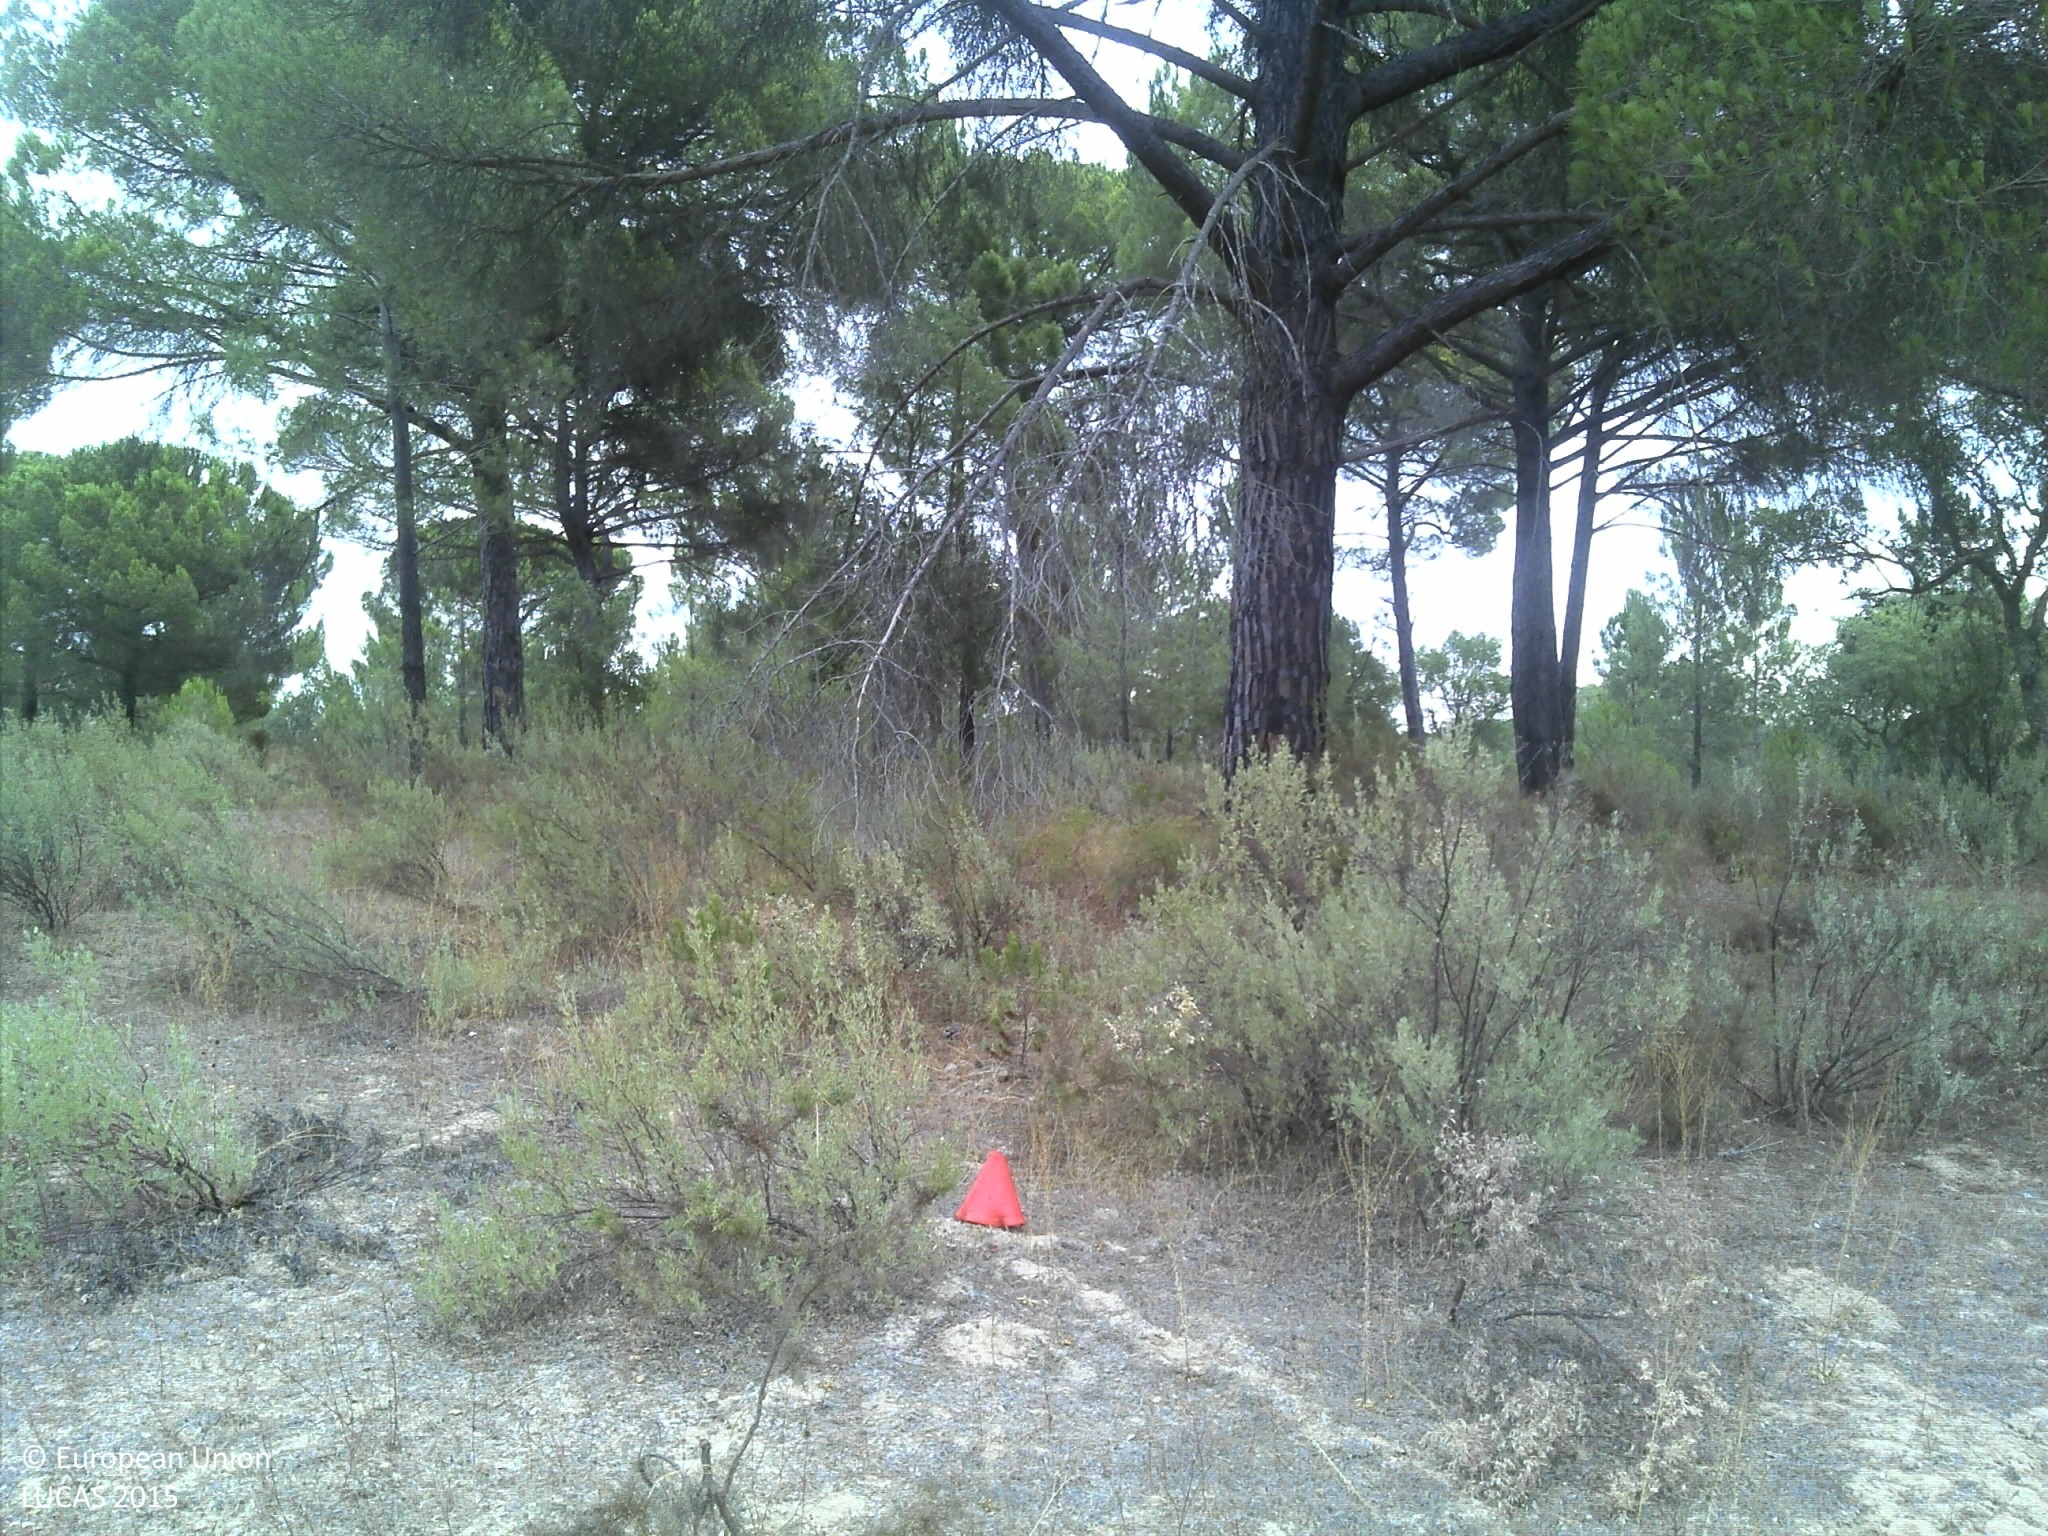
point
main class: Woodland
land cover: Pine dominated coniferous woodland
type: coniferous forest of the mediterranean region
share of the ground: 25 - 50 %
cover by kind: coniferous forest trees 45 %, shrubs 25 %, unconsolidated bare surface 20 %, herbaceous plants 10 %
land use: Forestry
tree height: > 5 m
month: August
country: PT
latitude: 38.9284
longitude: -8.2456
